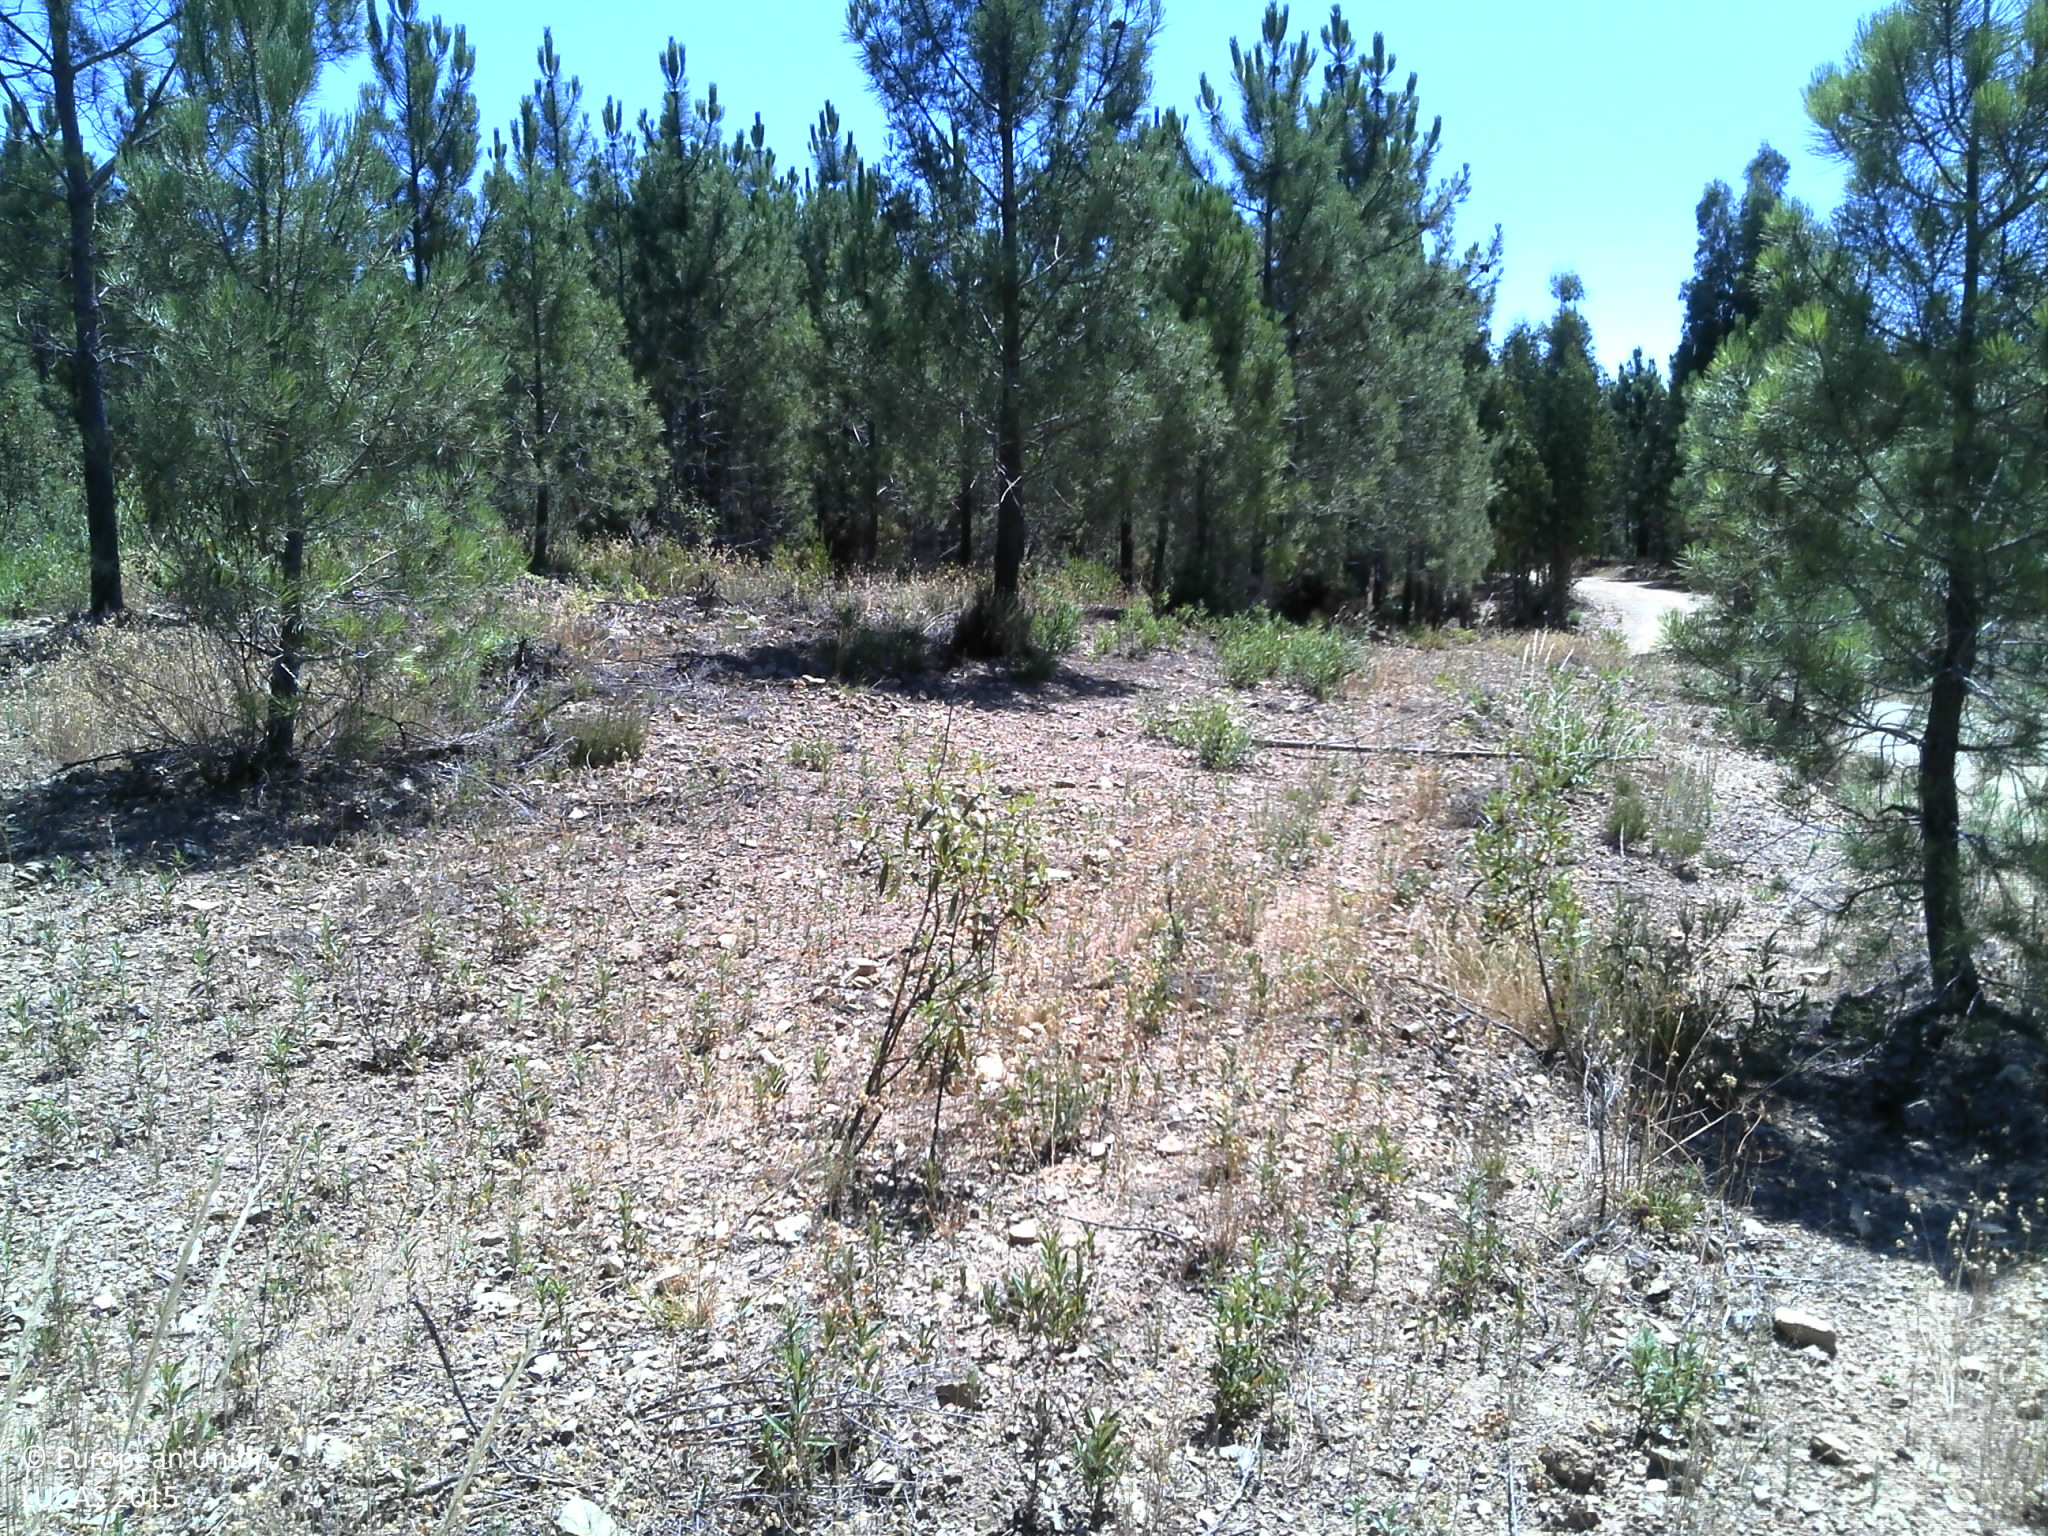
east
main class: Woodland
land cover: Pine dominated coniferous woodland
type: coniferous forest of the mediterranean region
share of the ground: 10 - 25 %
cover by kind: unconsolidated bare surface 60 %, shrubs 30 %, coniferous forest trees 10 %
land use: Forestry
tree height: > 5 m
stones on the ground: > 50 %
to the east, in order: Pine dominated coniferous woodland; Tracks; Pine dominated coniferous woodland; Broadleaved woodland
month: July
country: PT
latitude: 39.7333
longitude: -7.9972
